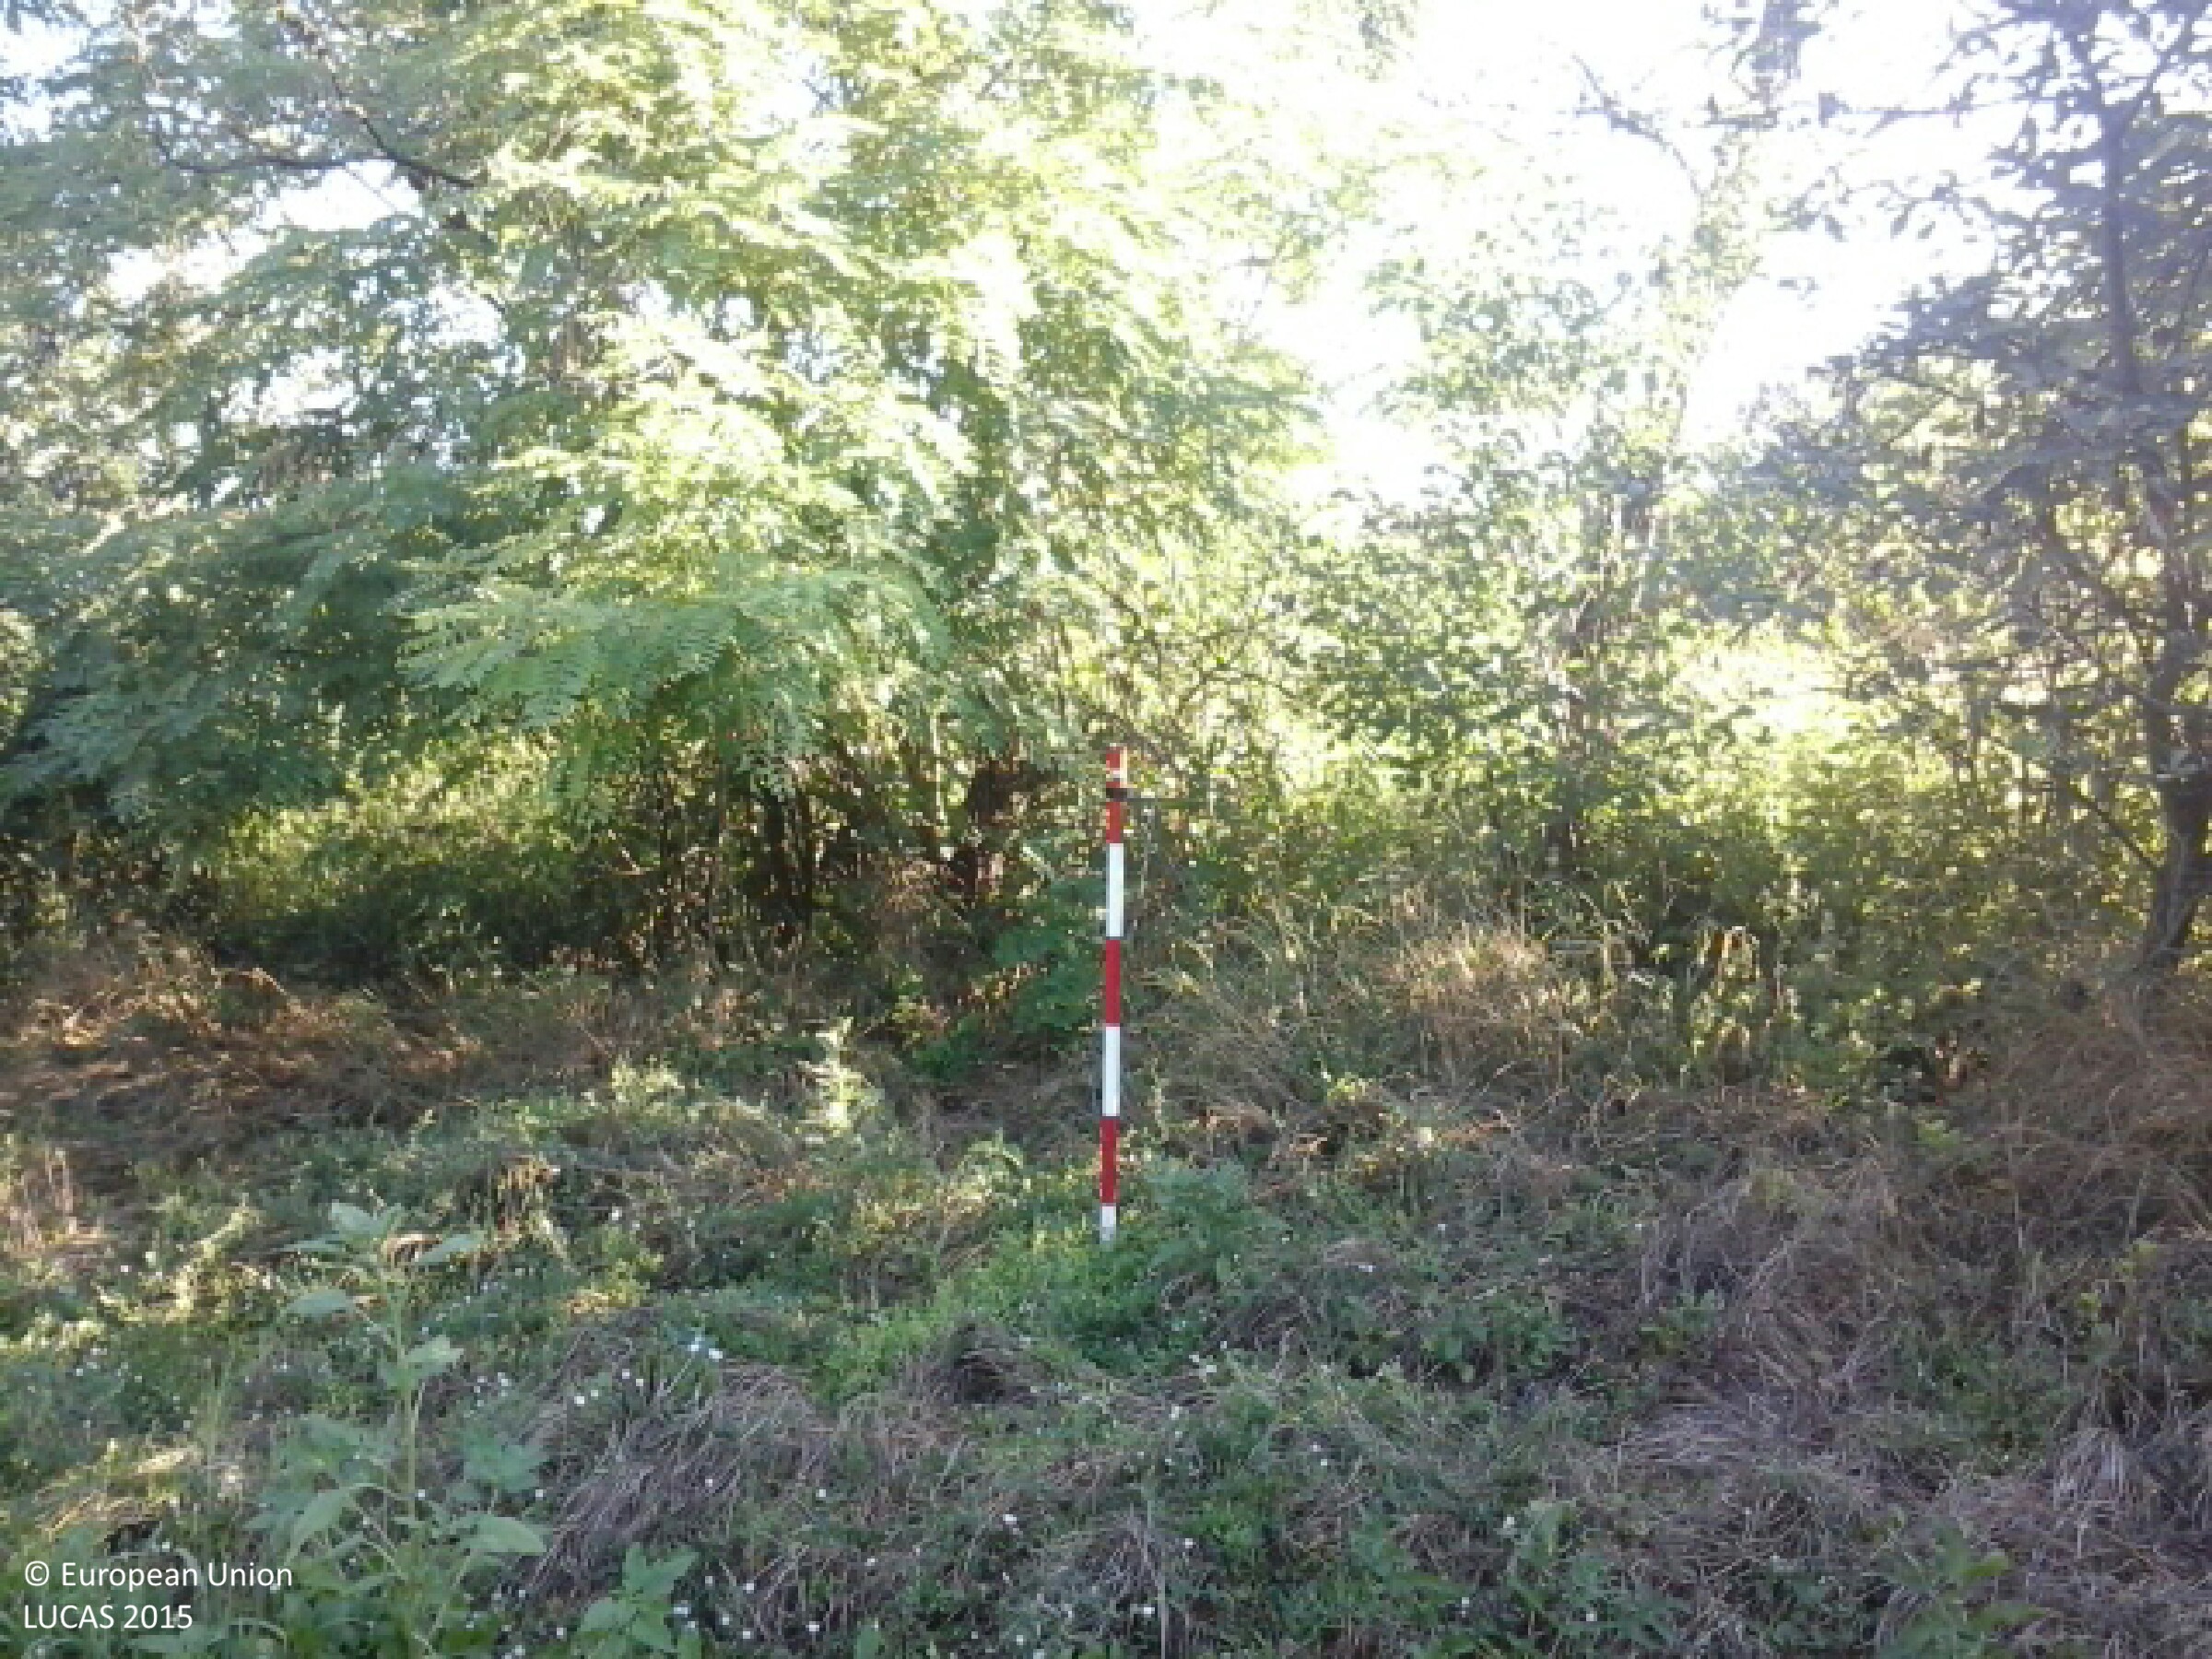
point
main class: Grassland
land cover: Grassland with sparse tree/shrub cover
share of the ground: > 75 %
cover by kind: herbaceous plants 90 %, broadleaved forest trees 5 %, shrubs 5 %
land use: Residential
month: July
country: HU
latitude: 48.2932
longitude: 21.1348
